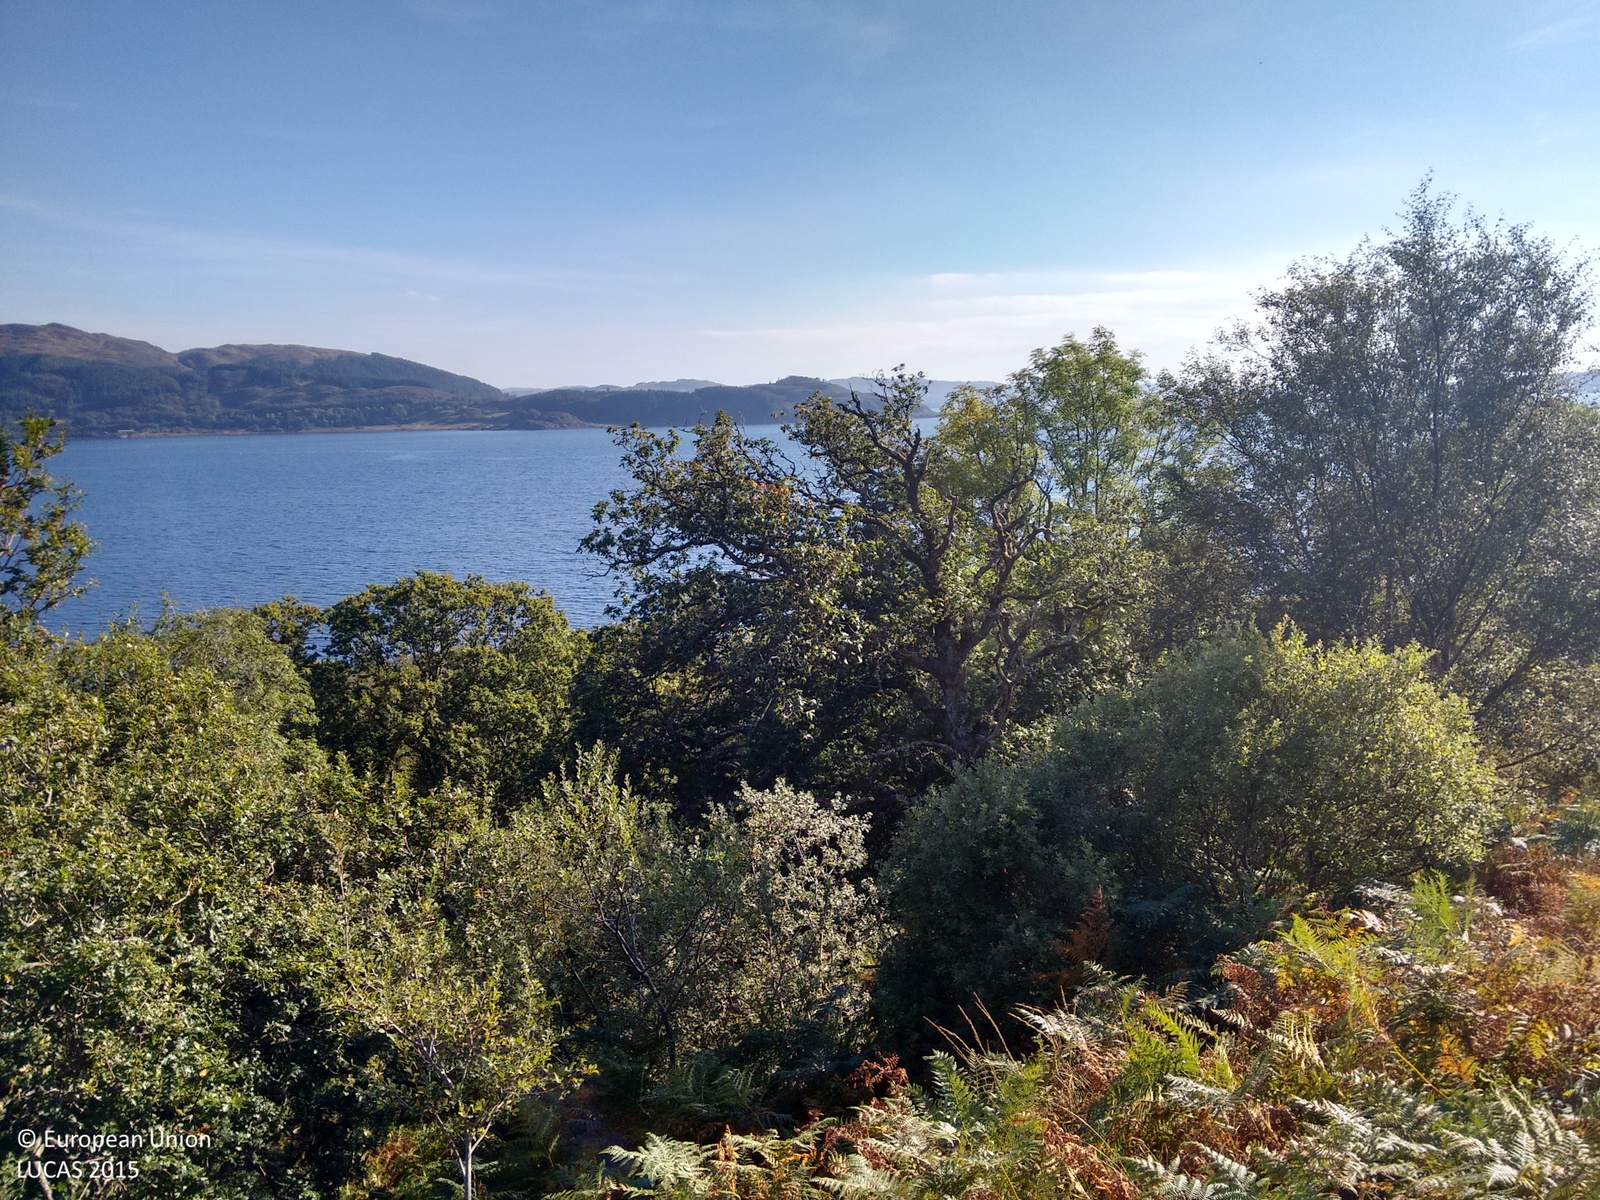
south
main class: Woodland
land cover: Broadleaved woodland
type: non-riverine alder, birch or aspen forest
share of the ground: > 75 %
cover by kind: broadleaved forest trees 95 %, shrubs 5 %
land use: Semi-natural and natural areas not in use
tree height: > 5 m
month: August
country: GB
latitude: 56.2565
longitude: -5.5710
